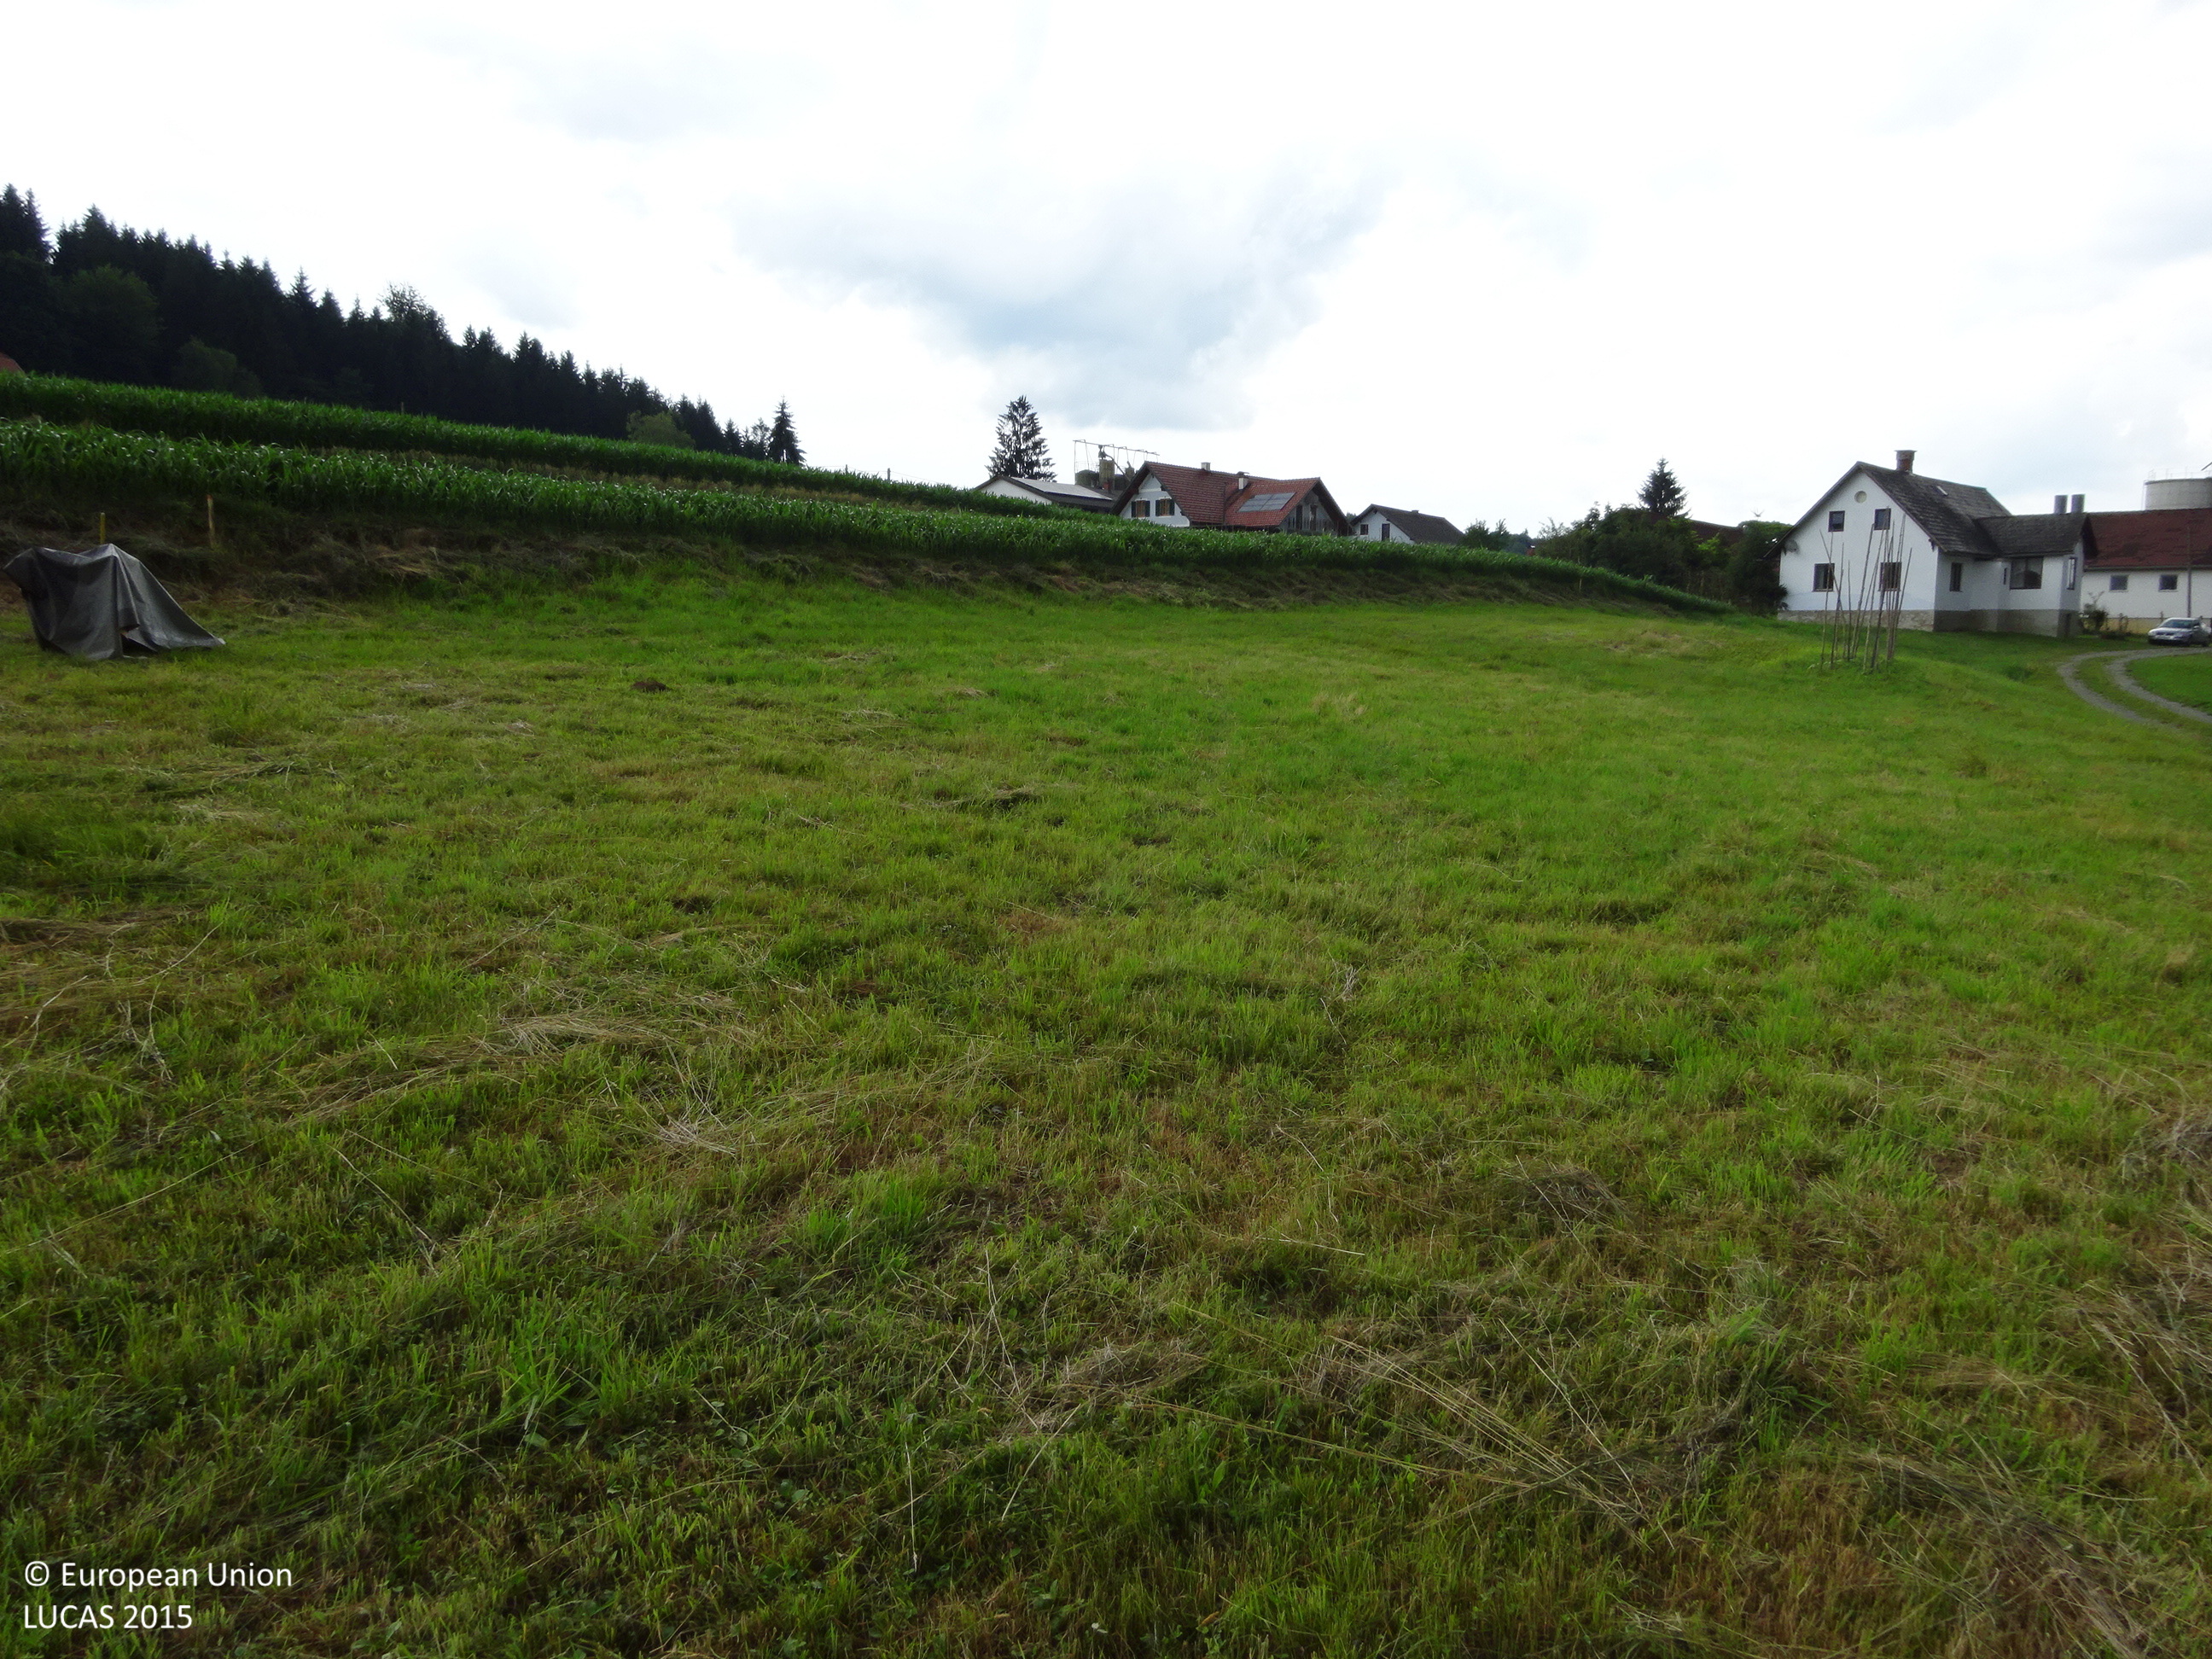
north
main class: Grassland
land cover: Grassland without tree/shrub cover
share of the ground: > 75 %
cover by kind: herbaceous plants 100 %
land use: Agriculture (excluding fallow land and kitchen gardens)
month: June
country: AT
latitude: 46.7201
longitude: 15.4023
